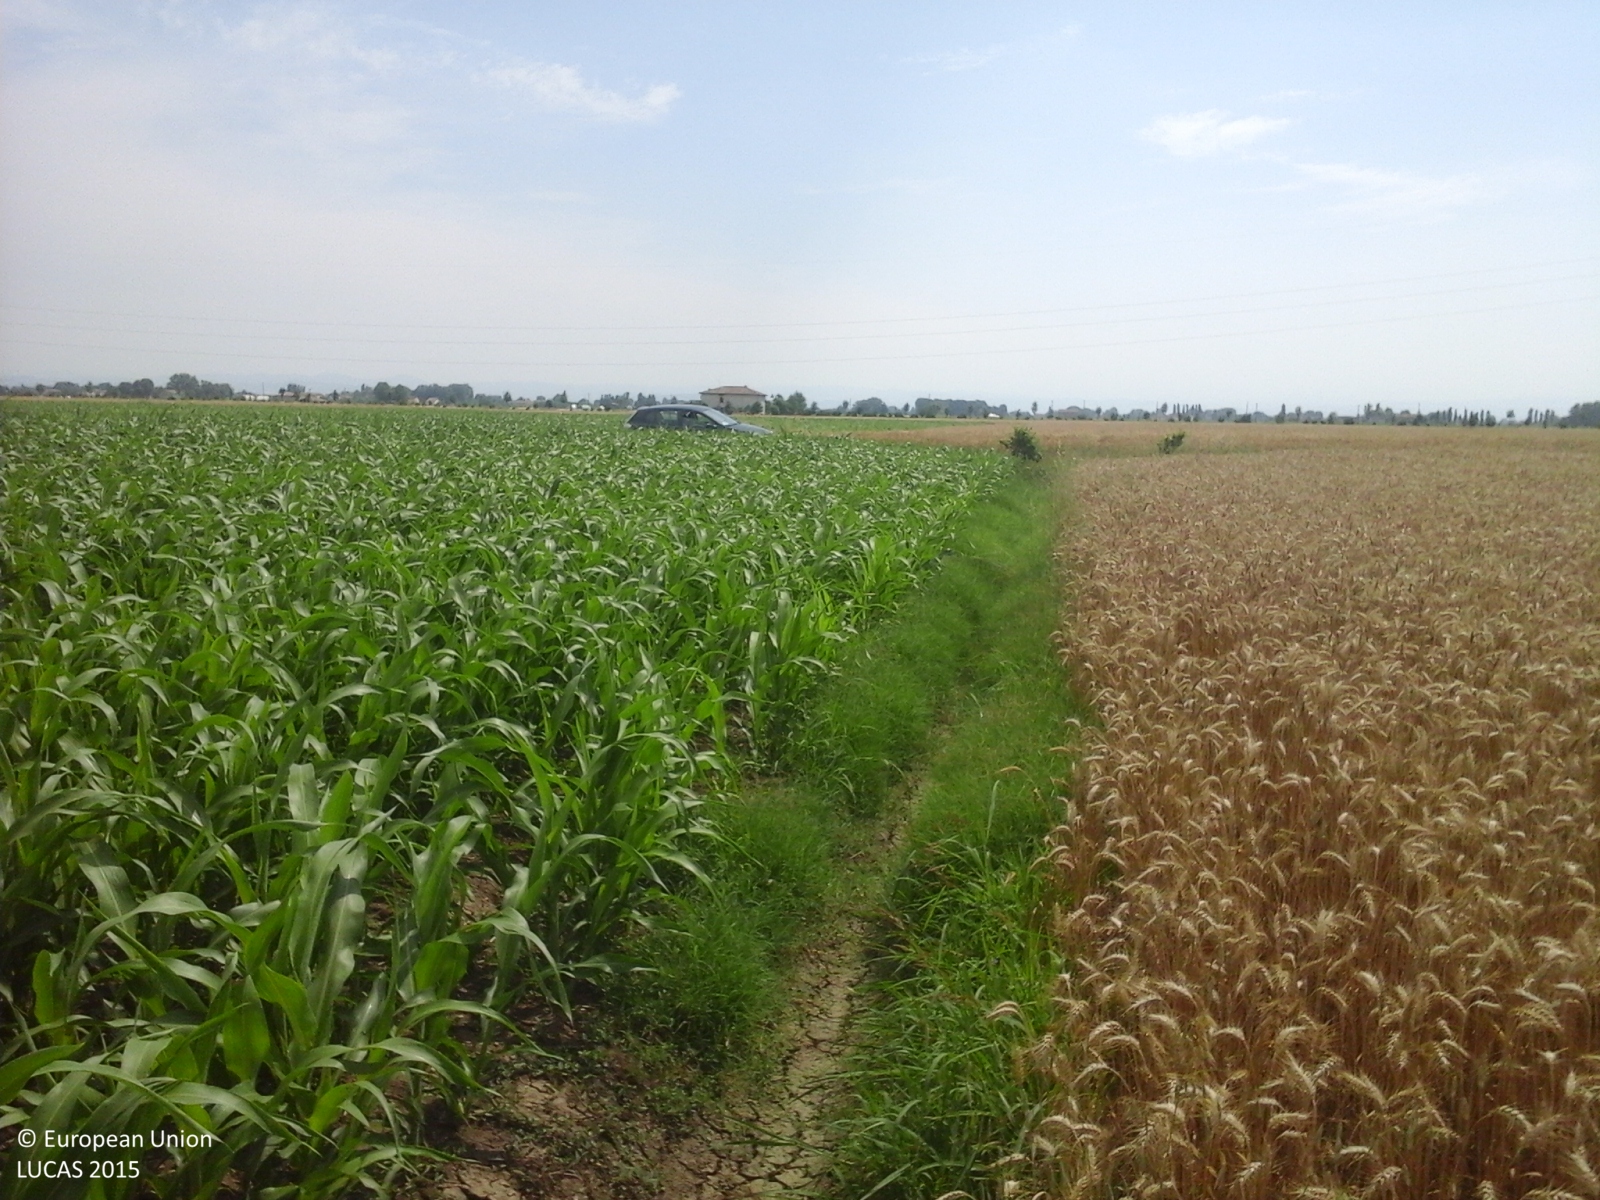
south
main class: Cropland
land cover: Common wheat
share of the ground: > 75 %
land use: Agriculture (excluding fallow land and kitchen gardens)
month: June
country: IT
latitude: 44.6872
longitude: 11.1206
